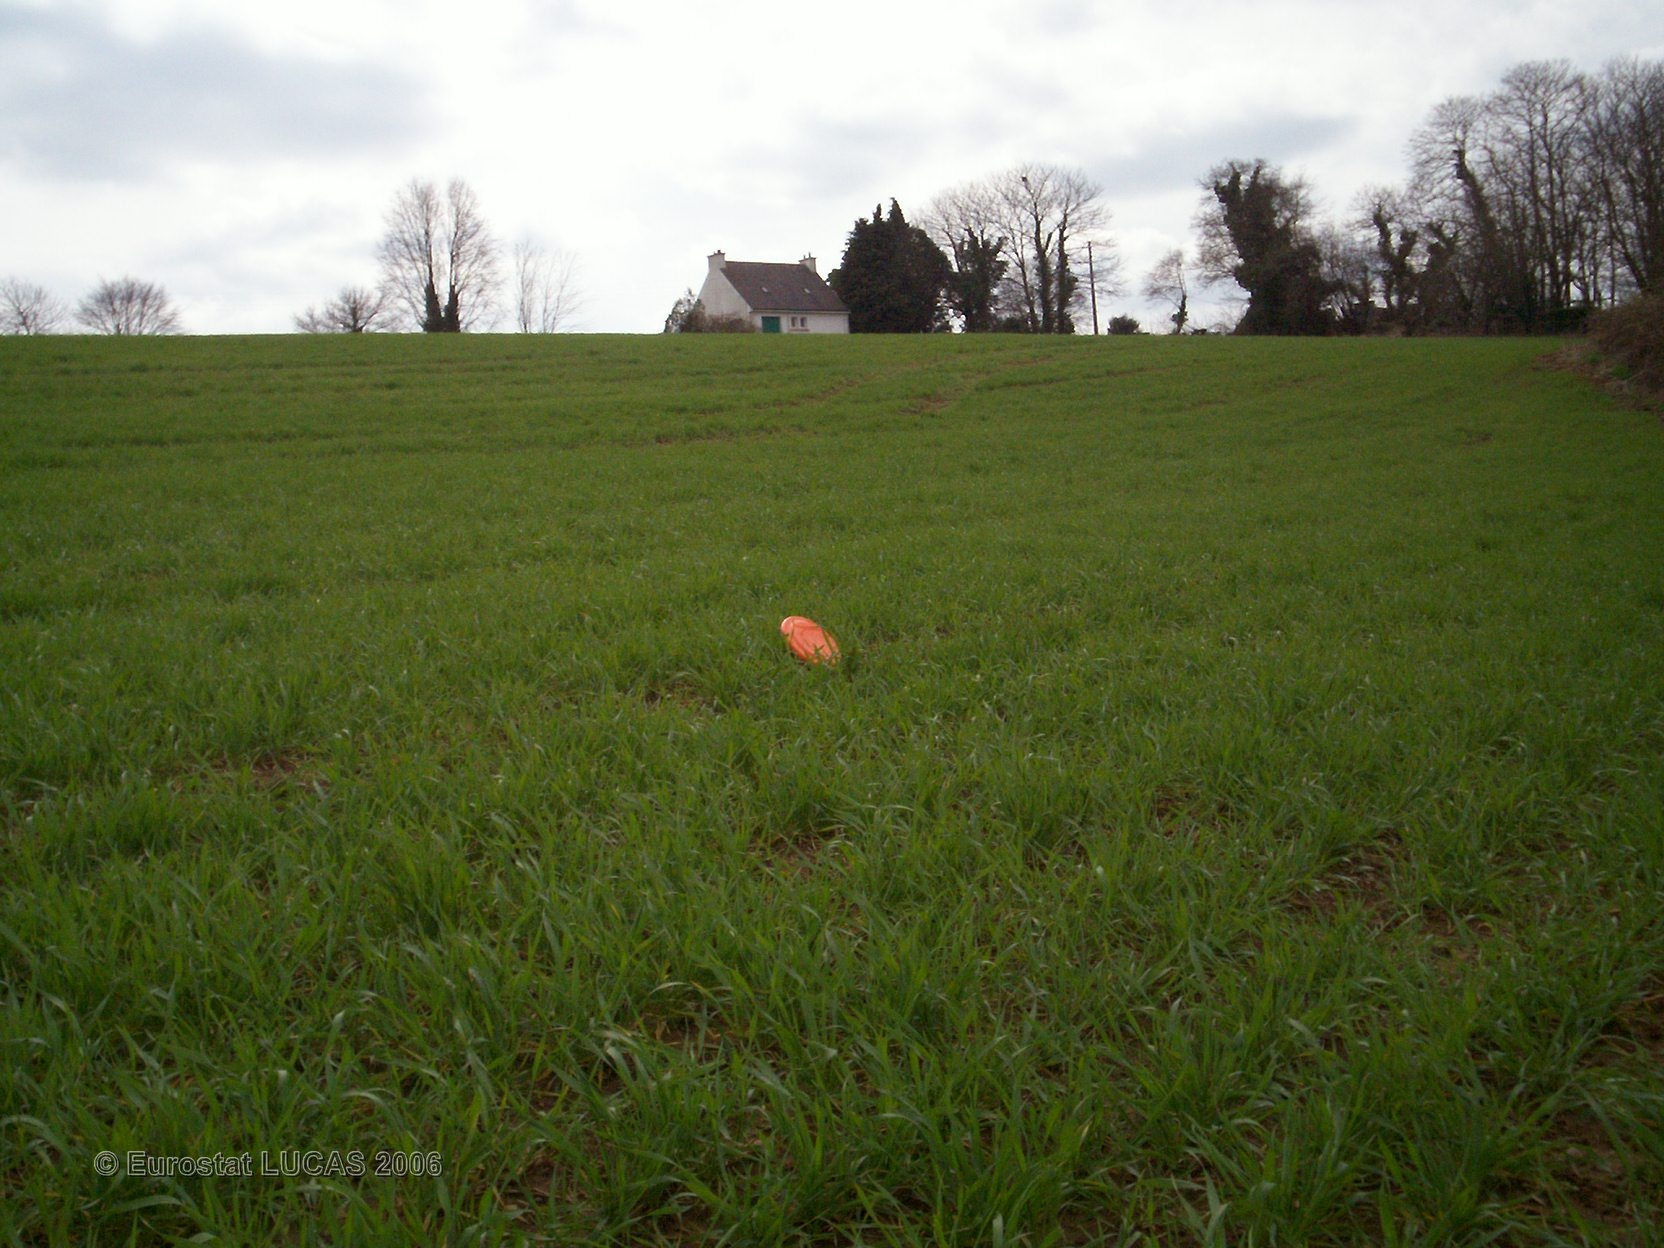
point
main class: Cropland
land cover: Common wheat
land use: Agriculture (excluding fallow land and kitchen gardens)
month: April
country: FR
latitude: 48.1262
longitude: -3.5813
